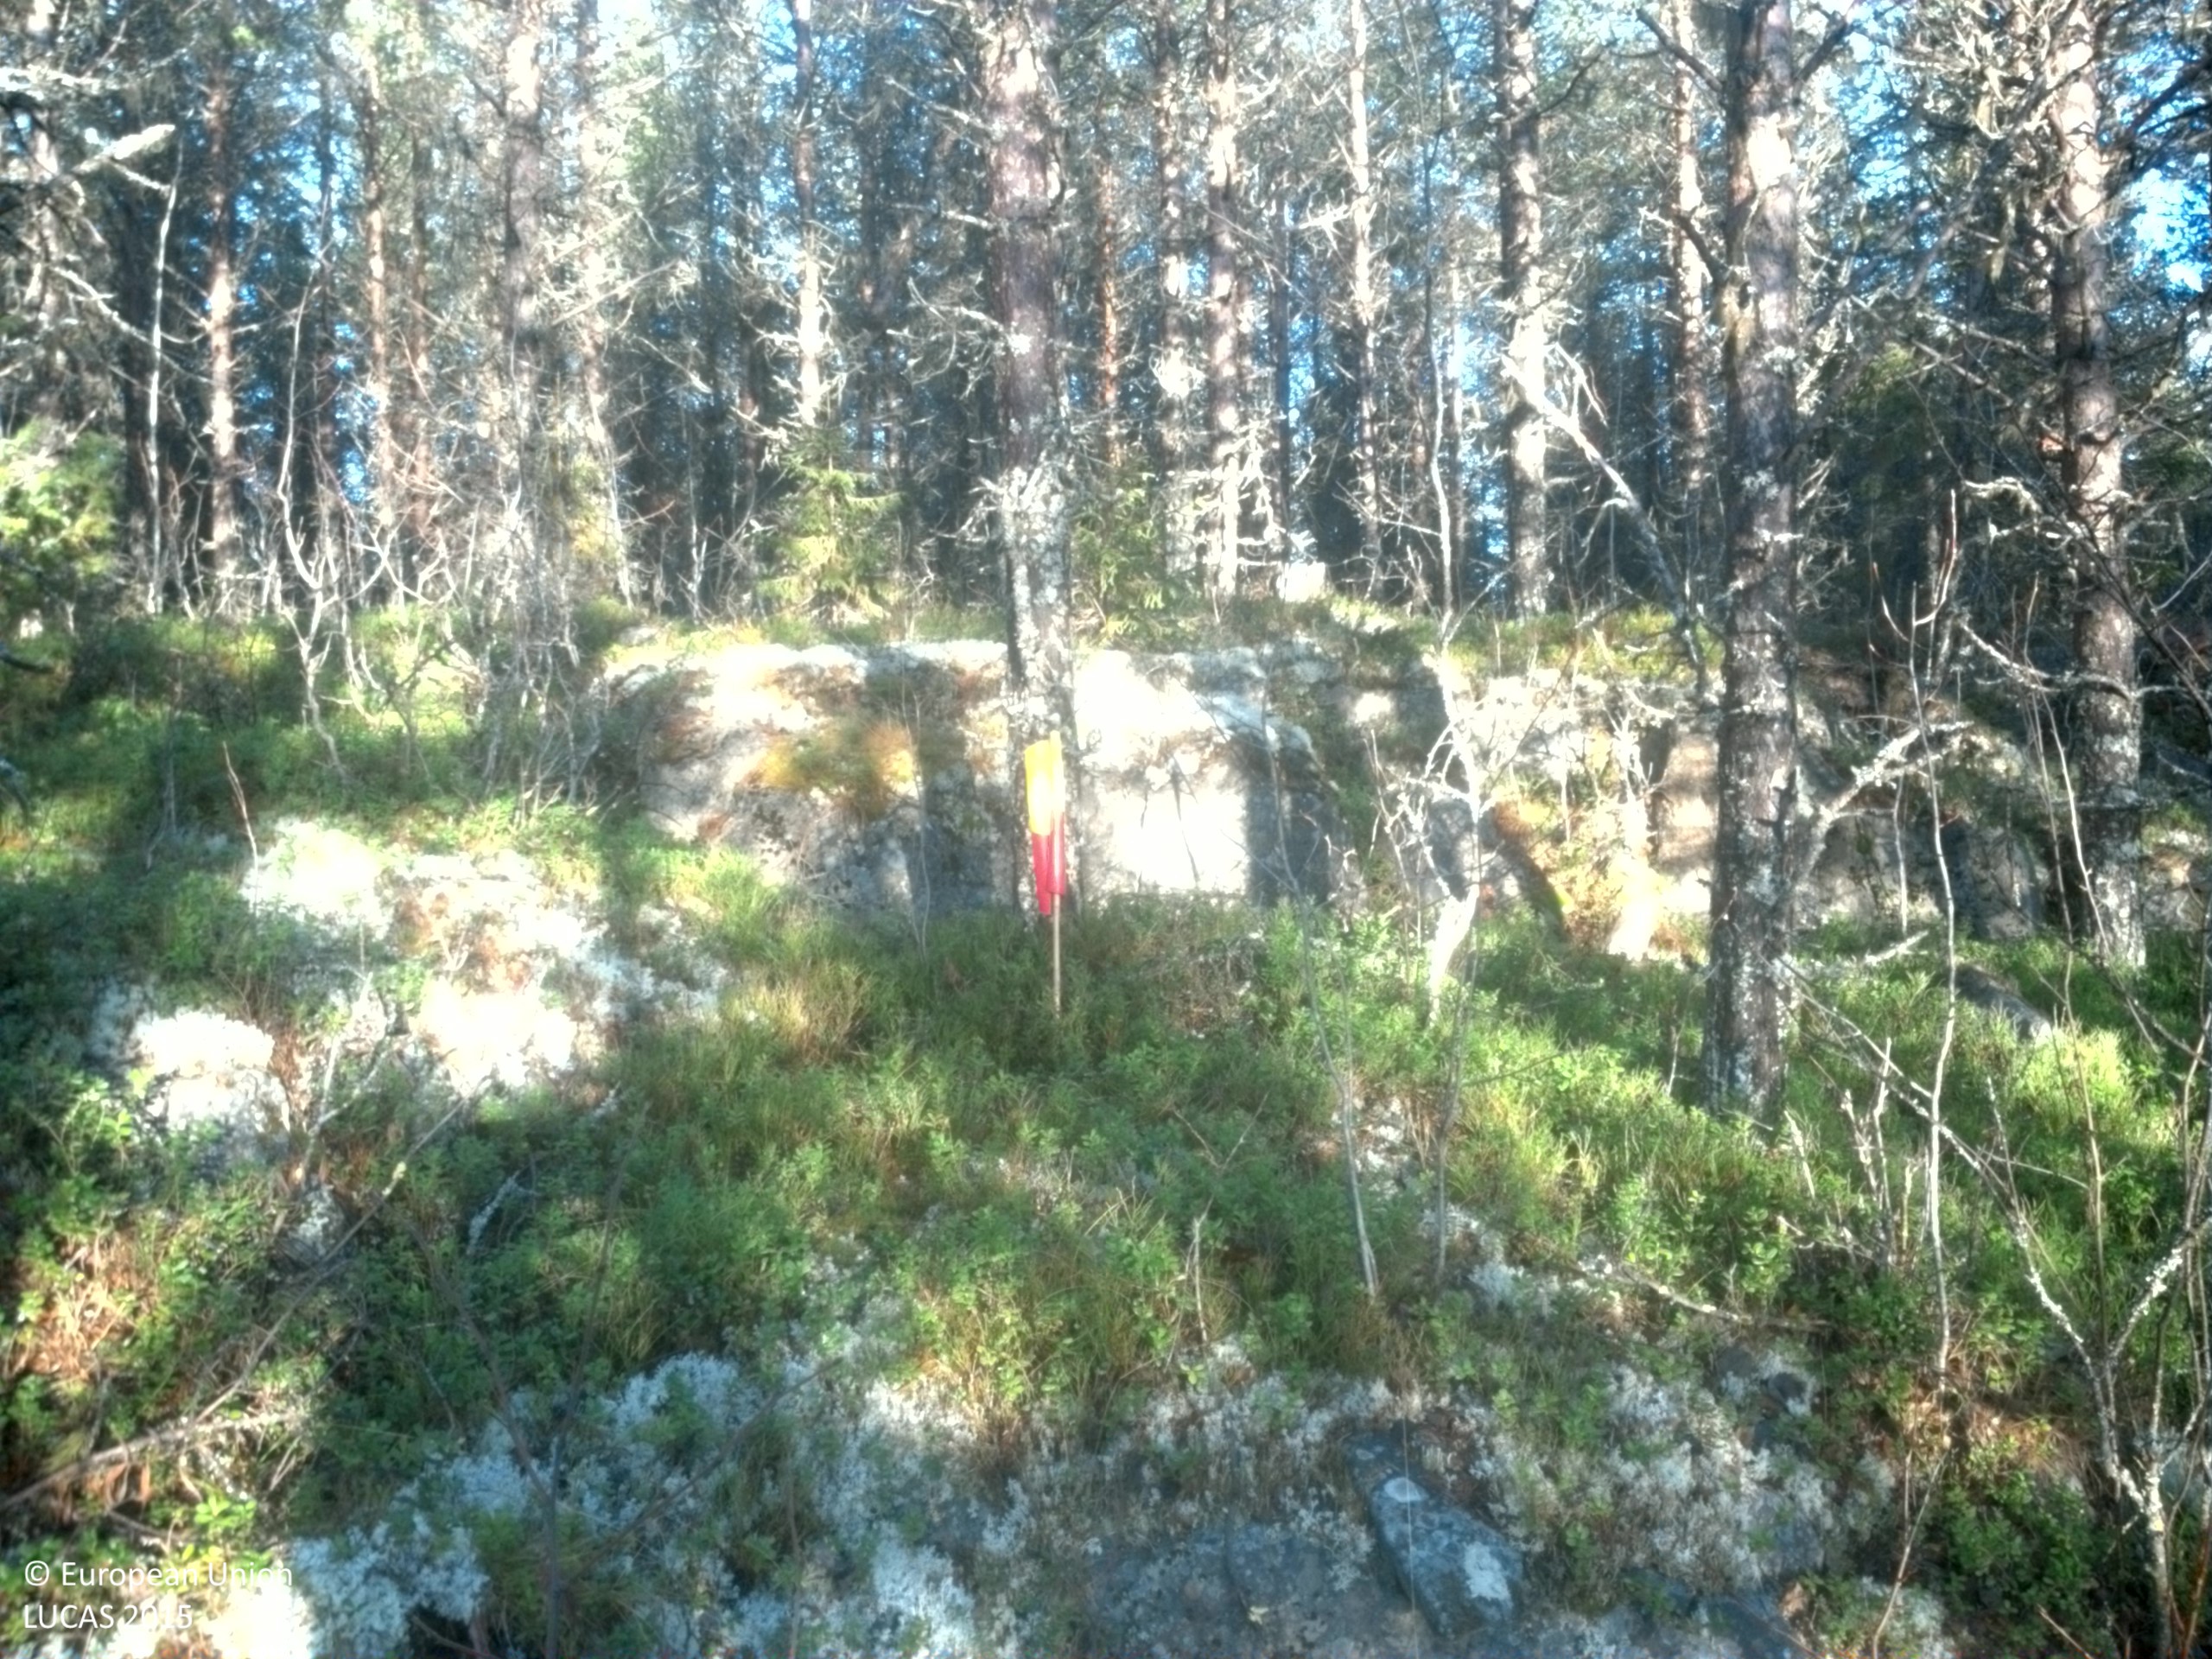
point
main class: Woodland
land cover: Pine dominated coniferous woodland
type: boreal forest
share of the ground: 50 - 75 %
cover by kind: coniferous forest trees 45 %, shrubs 30 %, lichens and mosses 15 %, broadleaved forest trees 5 %, consolidated bare surface 5 %
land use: Forestry
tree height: > 5 m
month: November
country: SE
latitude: 63.9604
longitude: 15.9541
